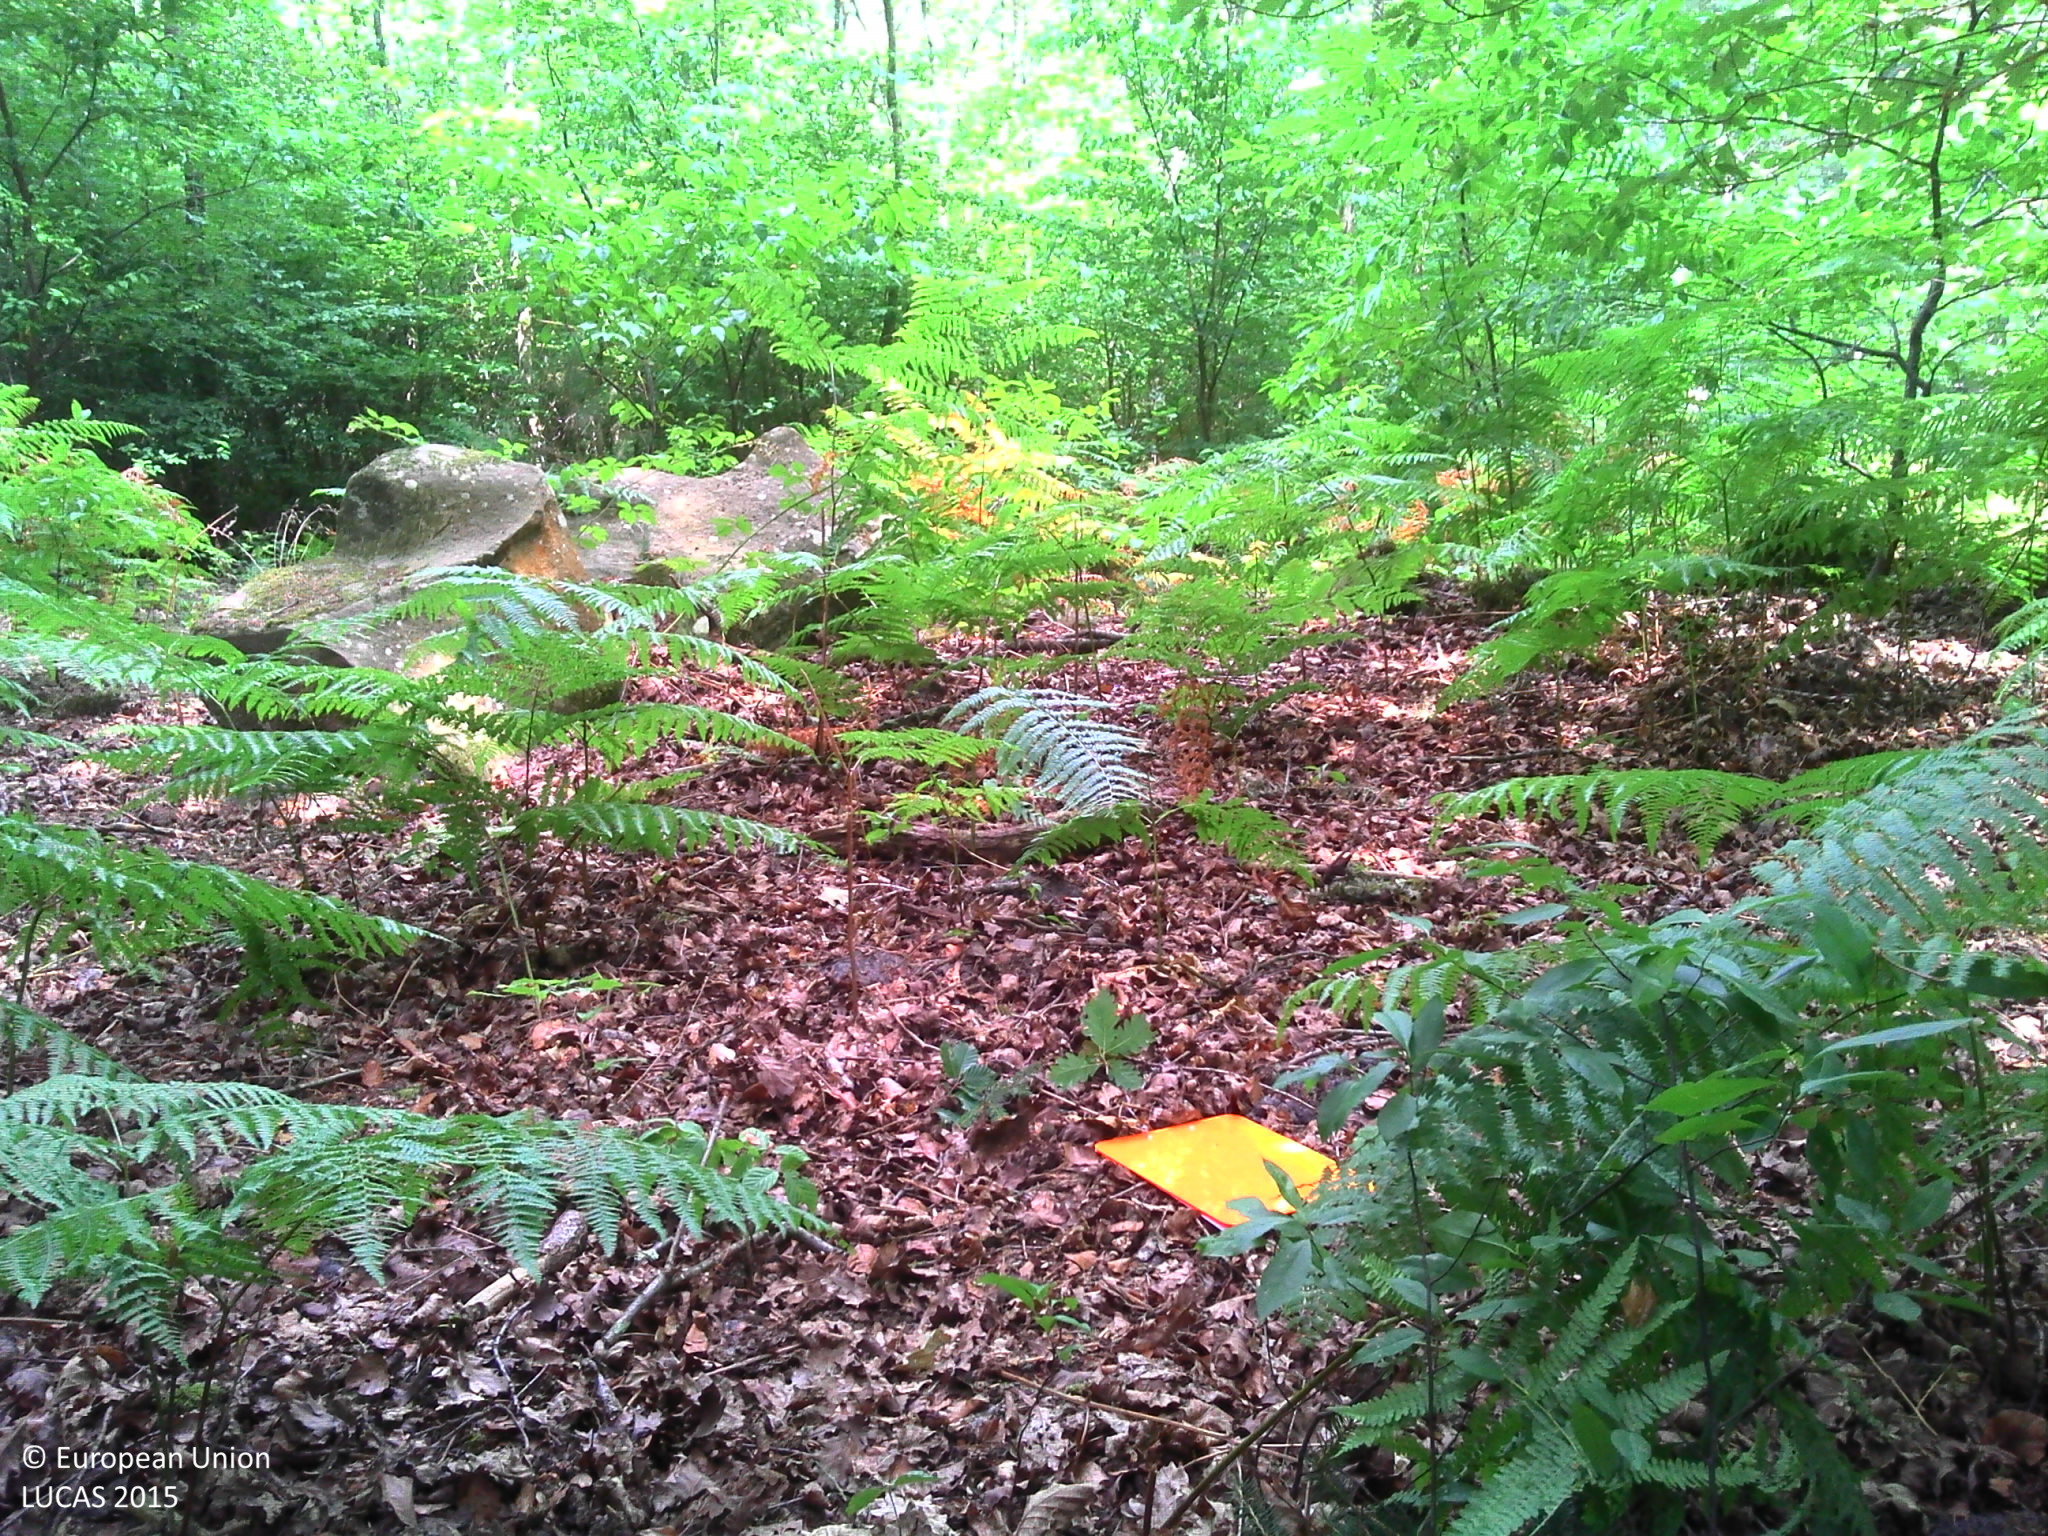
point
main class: Woodland
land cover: Pine dominated mixed woodland
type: hemiboreal forest and nemoral coniferous forest and mixed broadleaved-coniferous forest
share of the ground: > 75 %
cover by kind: coniferous forest trees 40 %, broadleaved forest trees 20 %, herbaceous plants 15 %, lichens and mosses 10 %, unconsolidated bare surface 10 %
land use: Forestry
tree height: > 5 m
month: July
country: FR
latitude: 48.4352
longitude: 2.7324
